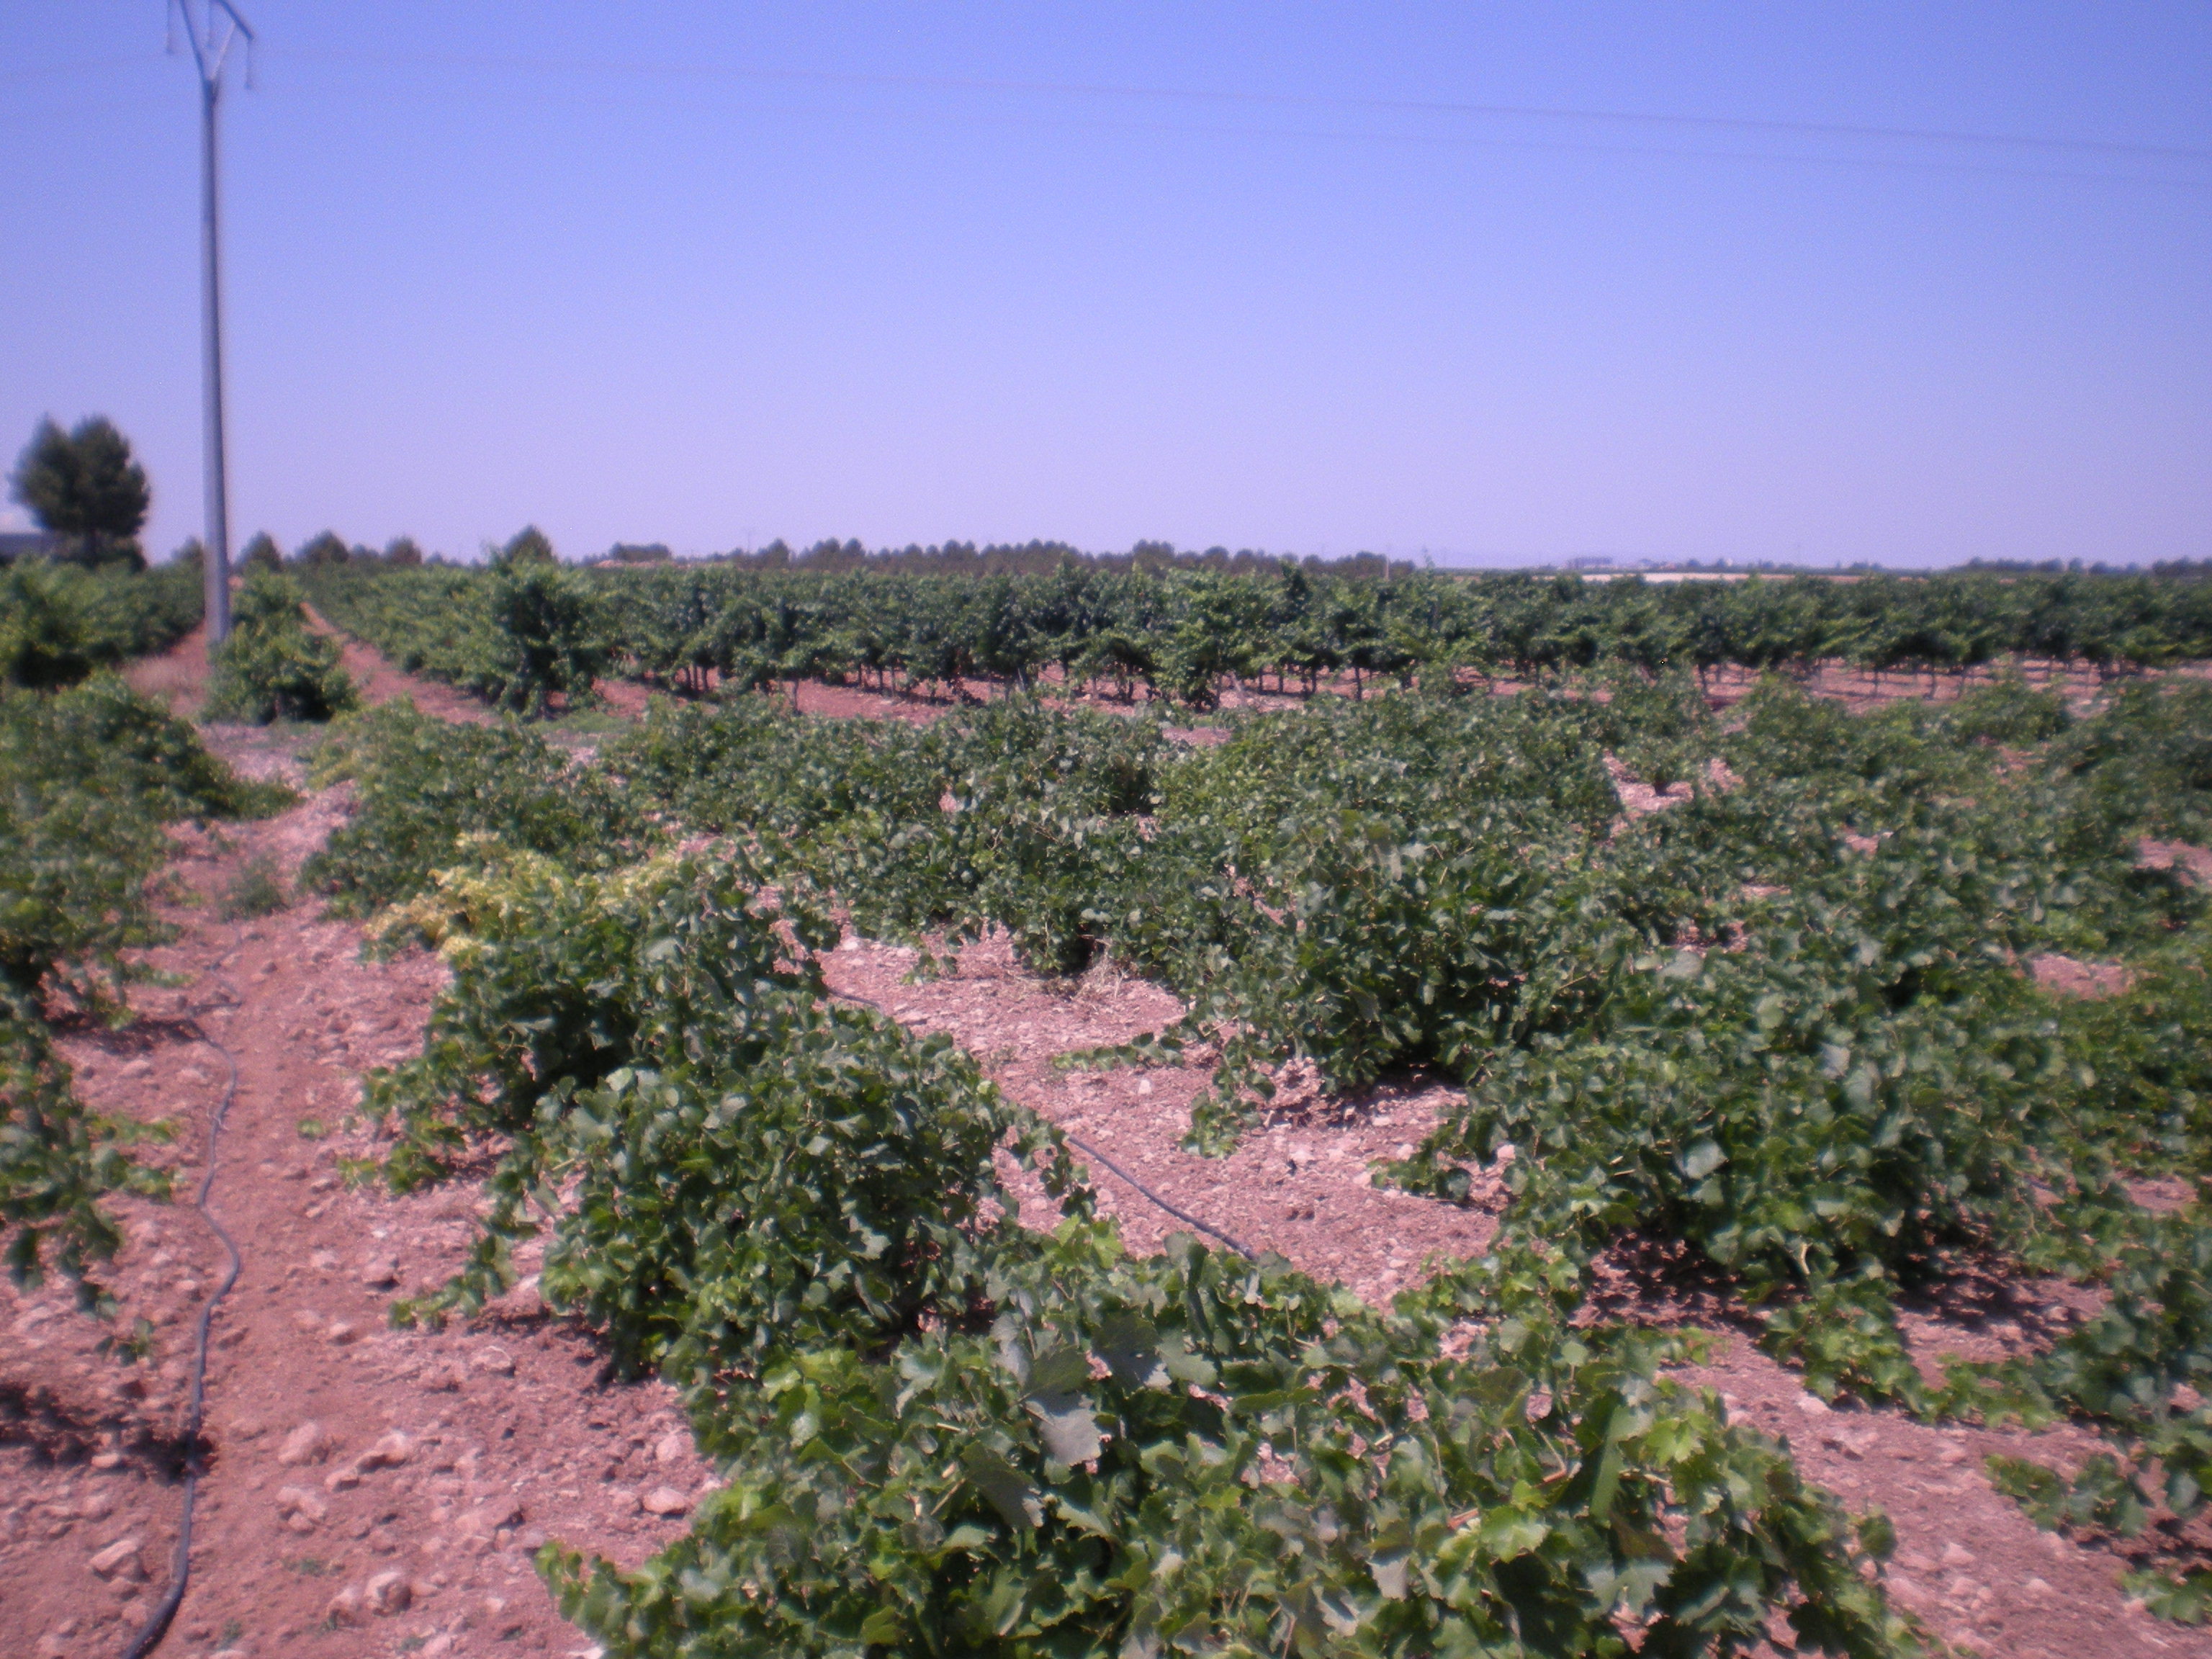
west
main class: Cropland
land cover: Vineyards
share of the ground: 25 - 50 %
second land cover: Other bare soil
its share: > 75 %
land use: Agriculture (excluding fallow land and kitchen gardens)
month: July
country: ES
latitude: 39.2569
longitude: -3.0985
